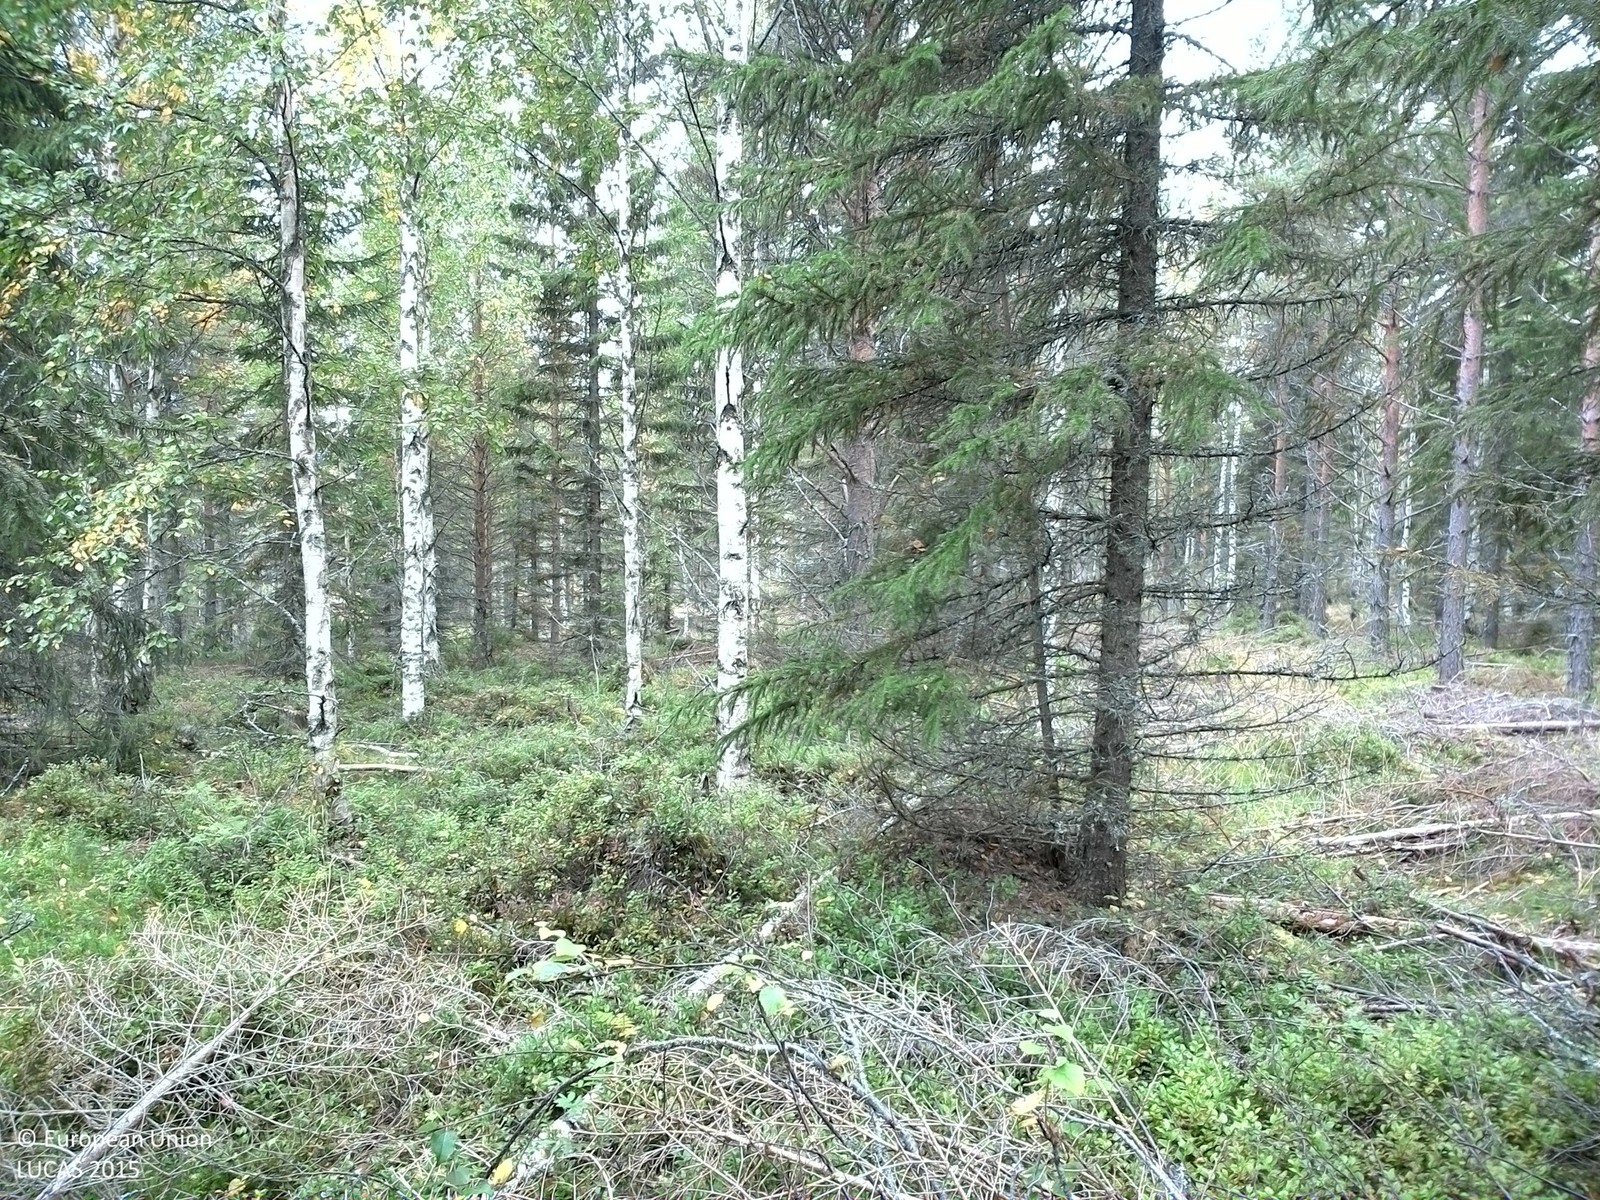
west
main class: Woodland
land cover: Other mixed woodland
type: boreal forest
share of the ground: 50 - 75 %
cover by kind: coniferous forest trees 30 %, broadleaved forest trees 30 %, shrubs 25 %, lichens and mosses 10 %, herbaceous plants 5 %
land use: Forestry
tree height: > 5 m
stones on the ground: 10 - 25 %
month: September
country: SE
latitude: 61.5691
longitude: 15.0865
